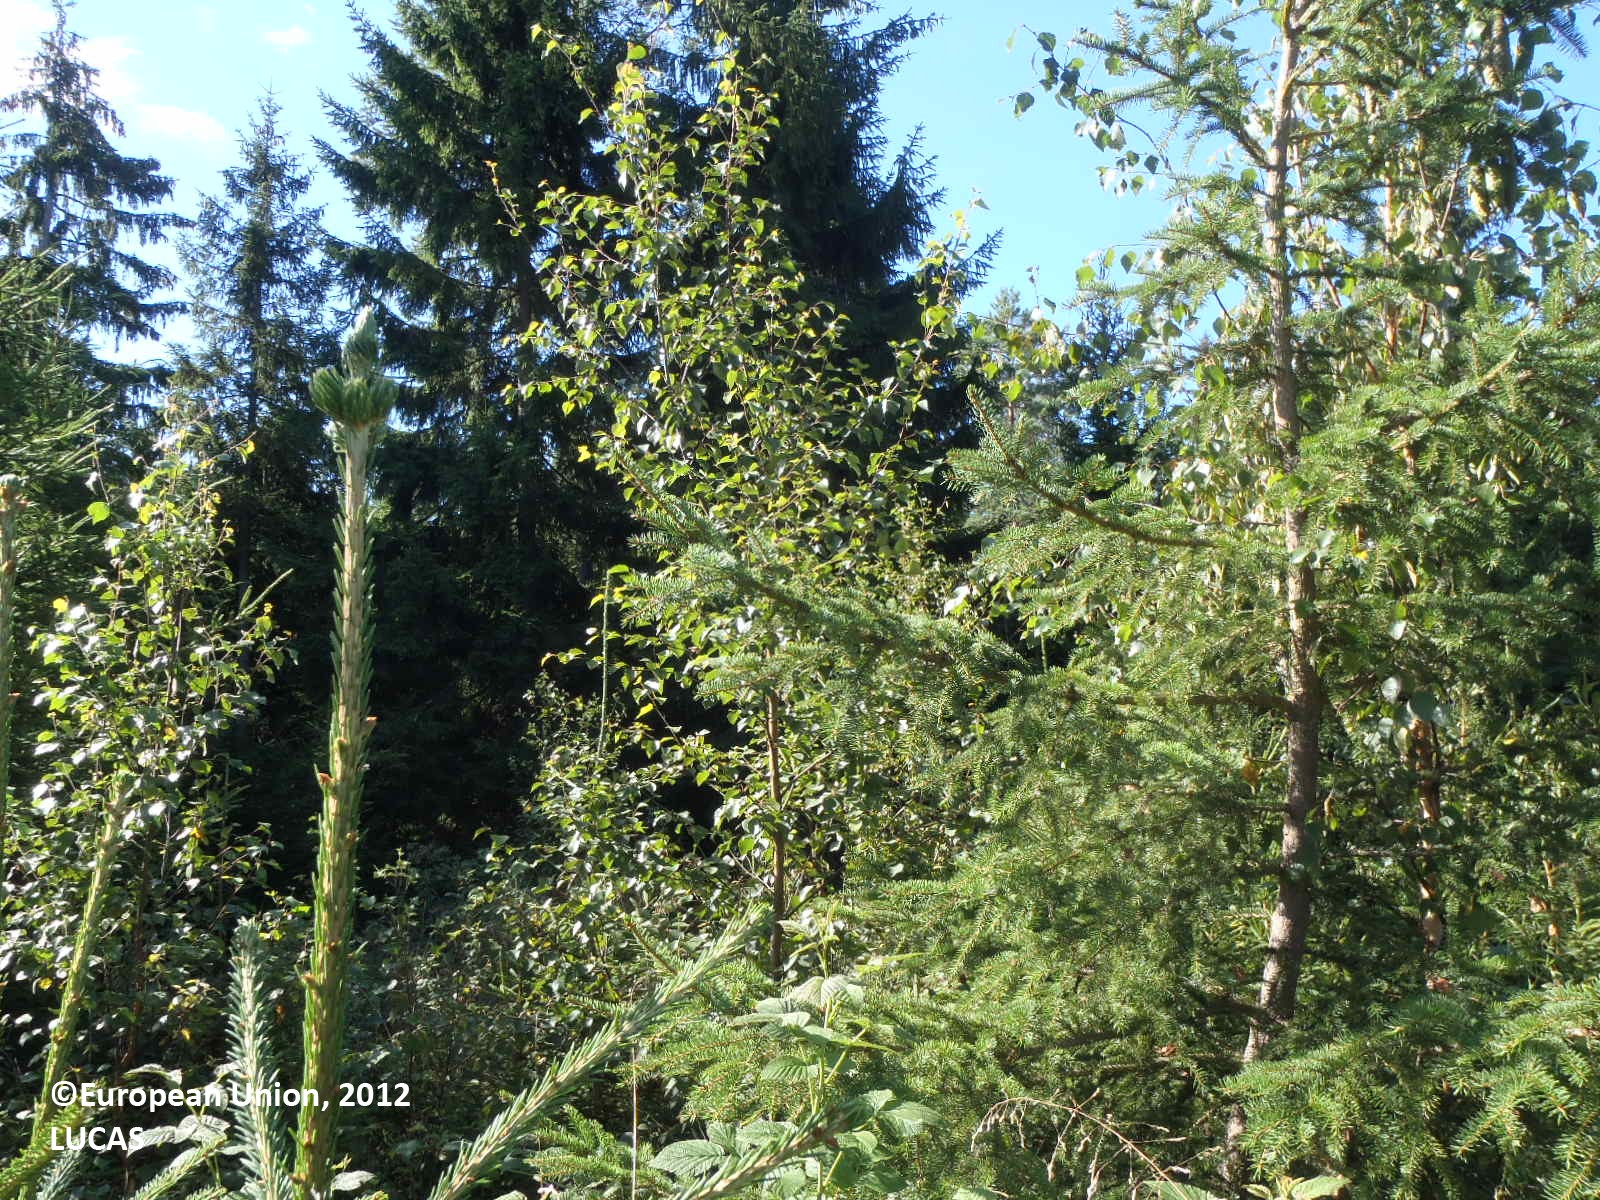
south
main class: Woodland
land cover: Spruce dominated mixed woodland
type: boreal forest
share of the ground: > 75 %
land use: Forestry
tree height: > 5 m
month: August
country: FI
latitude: 60.2455
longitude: 22.2616
